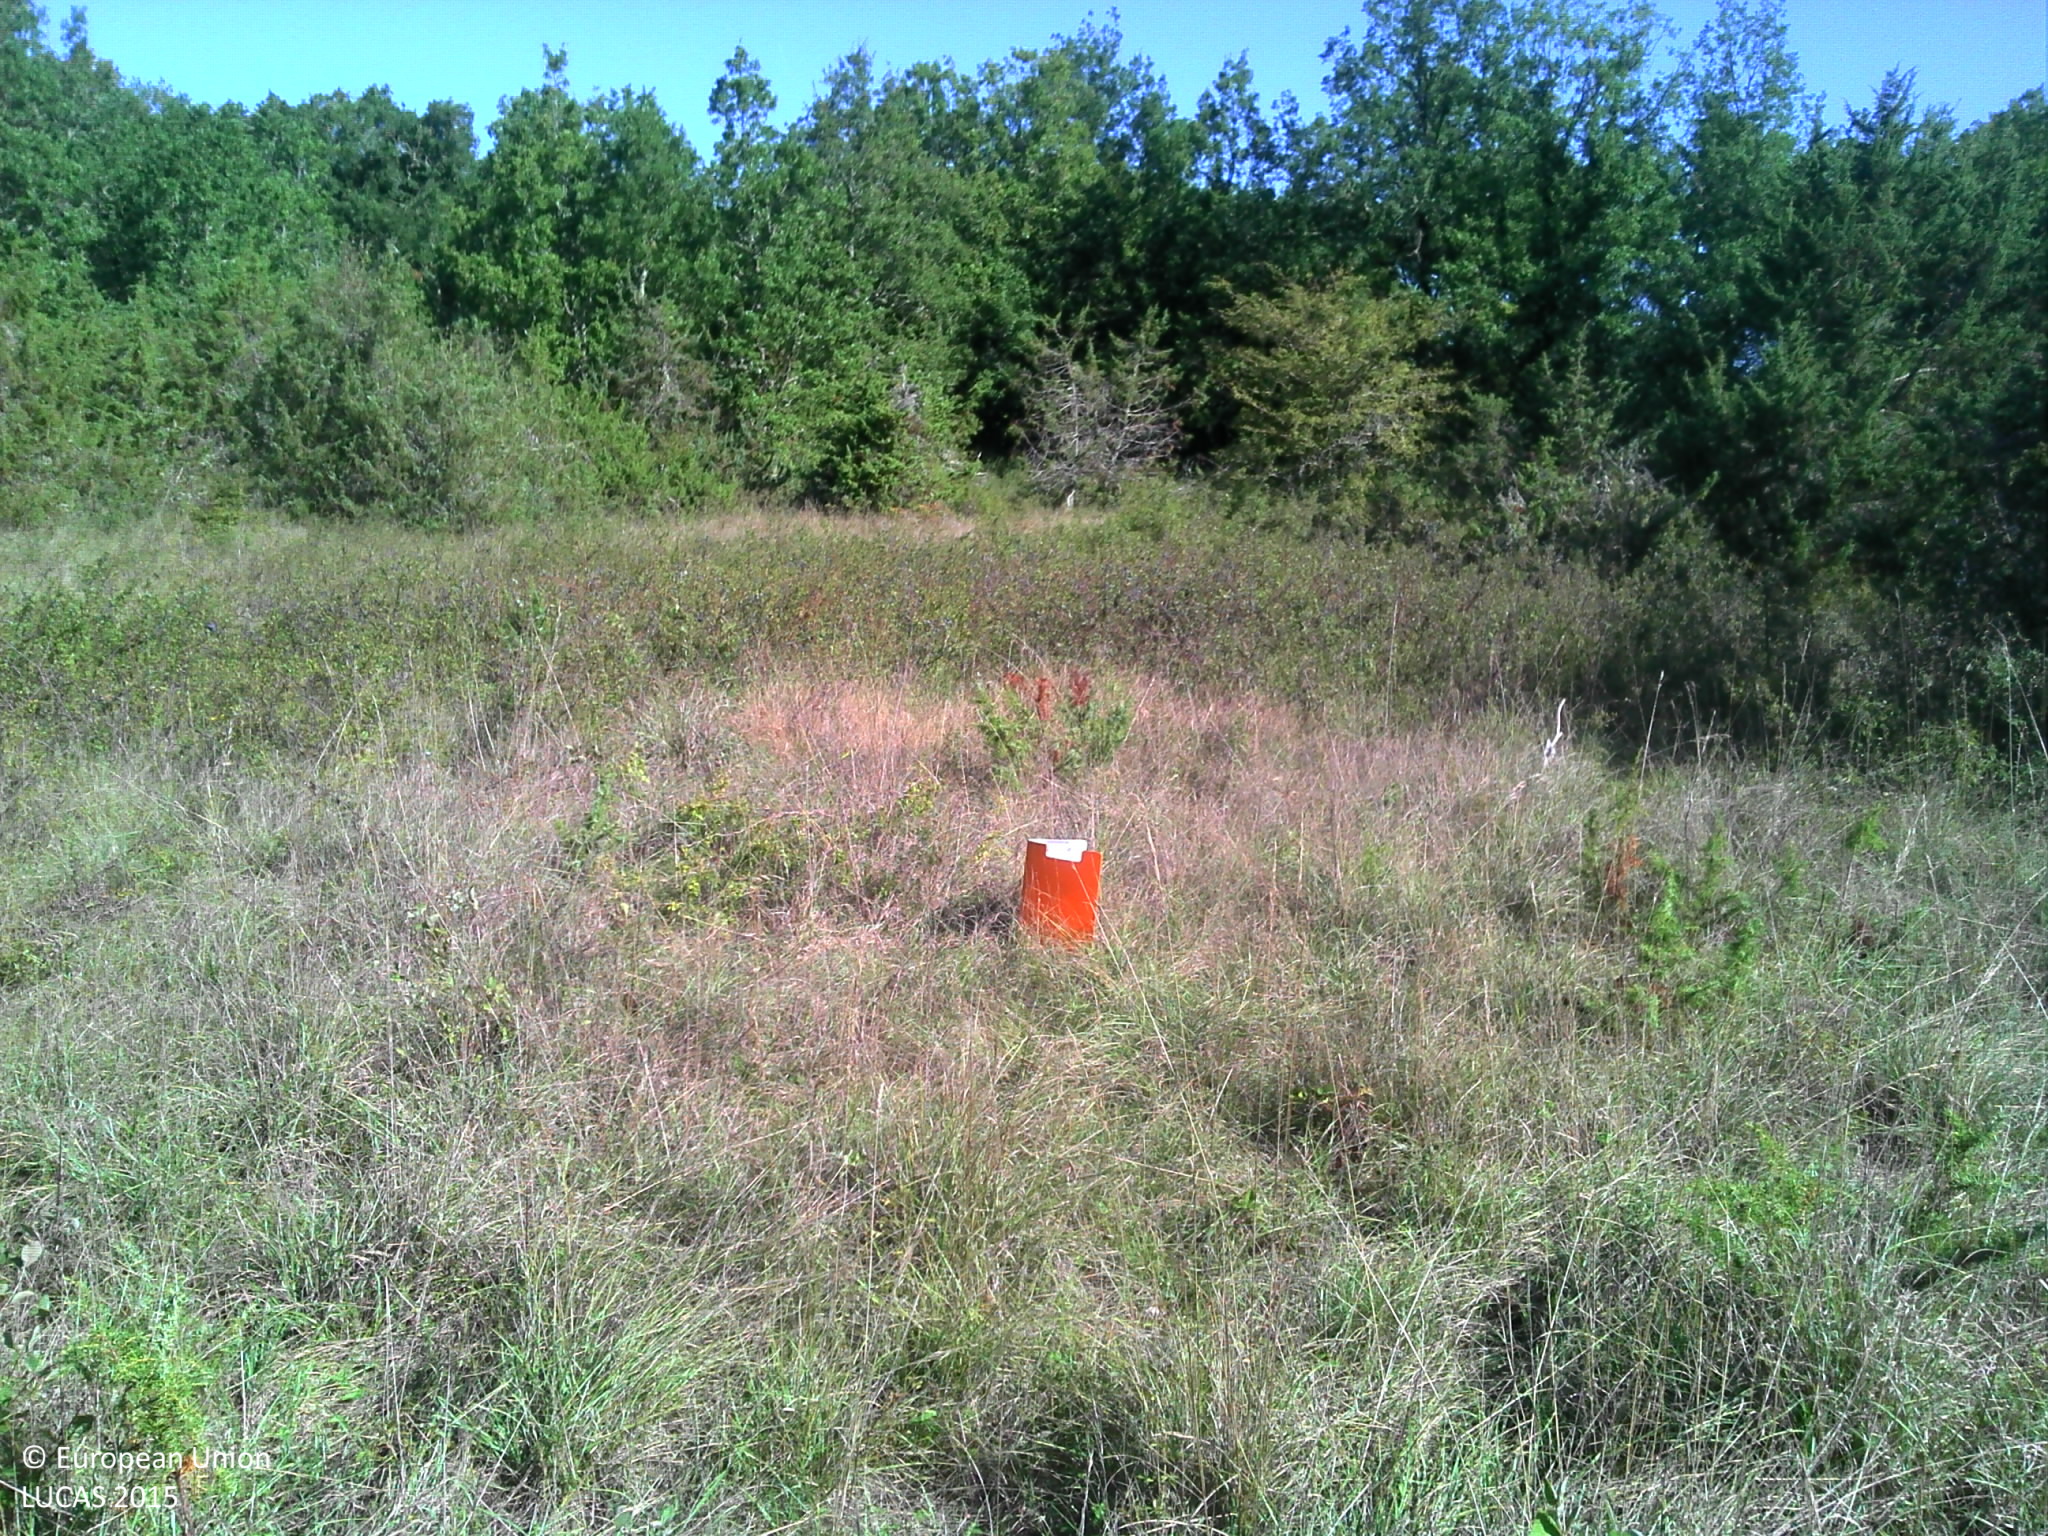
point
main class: Grassland
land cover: Grassland with sparse tree/shrub cover
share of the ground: > 75 %
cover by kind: herbaceous plants 85 %, shrubs 10 %, broadleaved forest trees 5 %
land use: Agriculture (excluding fallow land and kitchen gardens)
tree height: > 5 m
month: August
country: FR
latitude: 44.3564
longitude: 1.6312
